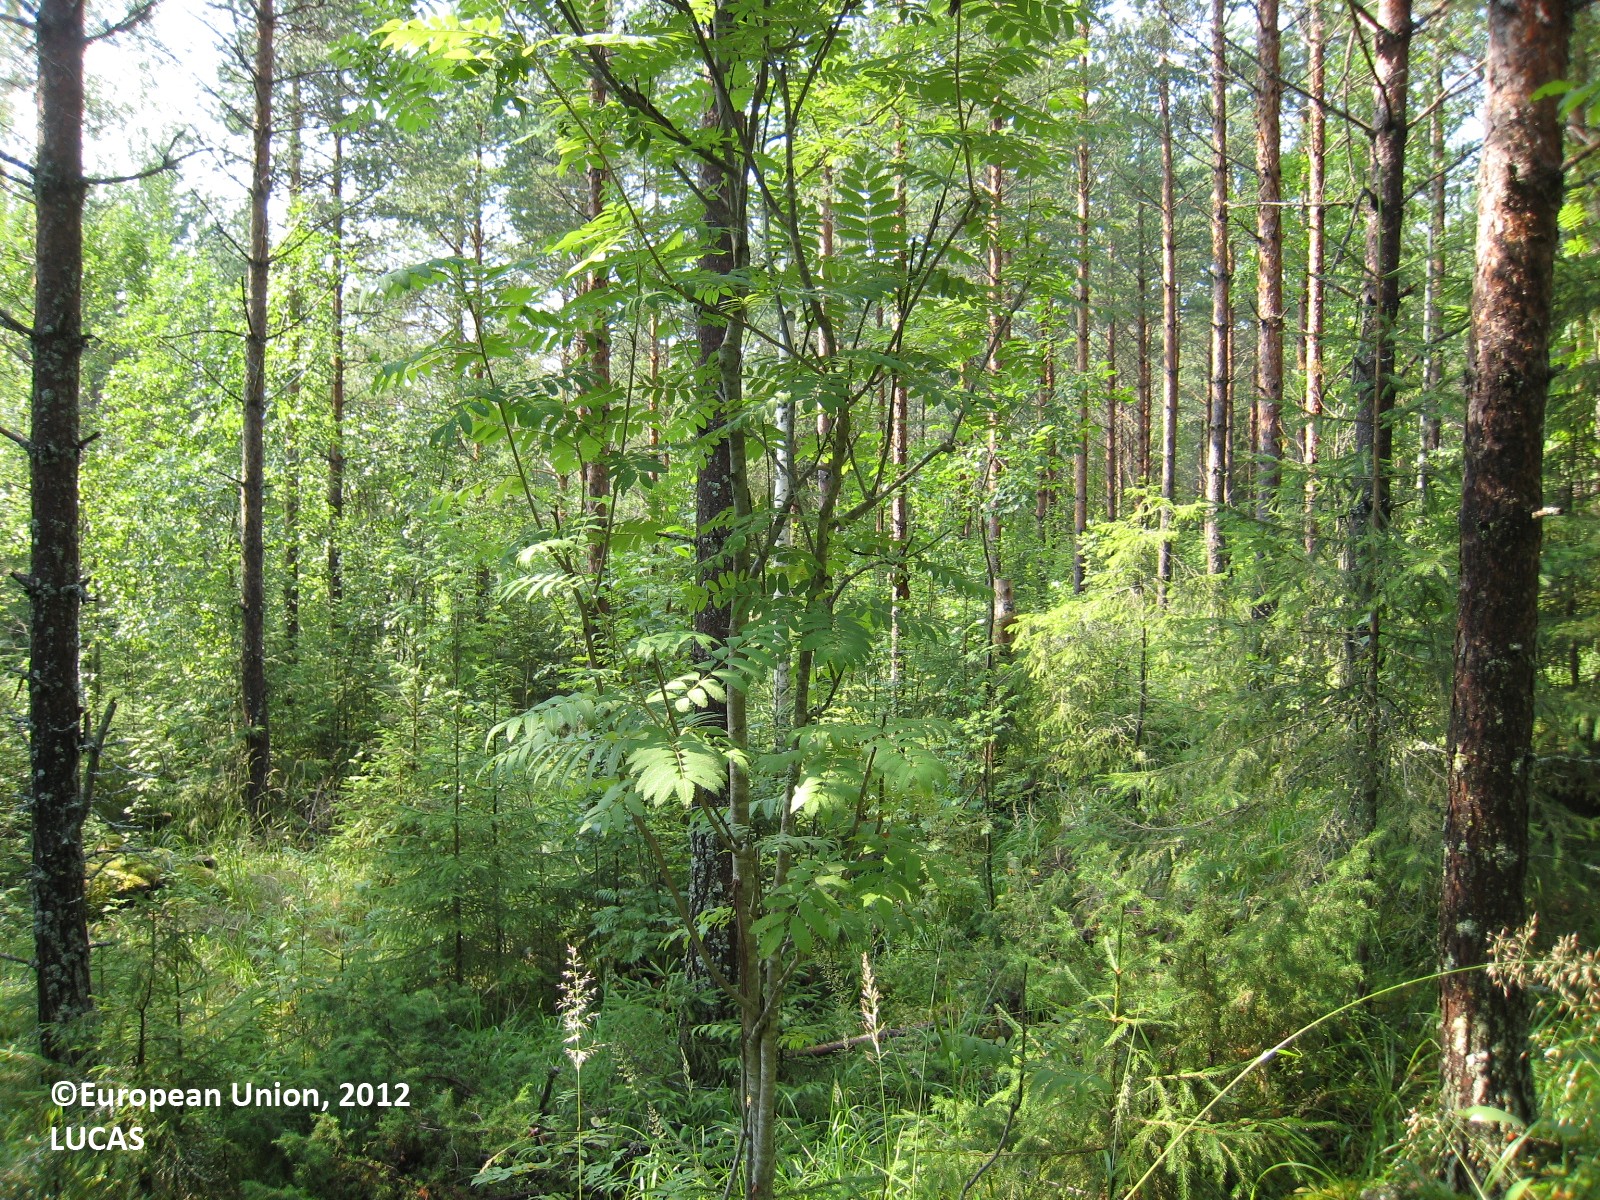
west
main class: Woodland
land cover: Other coniferous woodland
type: boreal forest
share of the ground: > 75 %
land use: Forestry
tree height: > 5 m
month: July
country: FI
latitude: 62.4588
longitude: 27.3985
